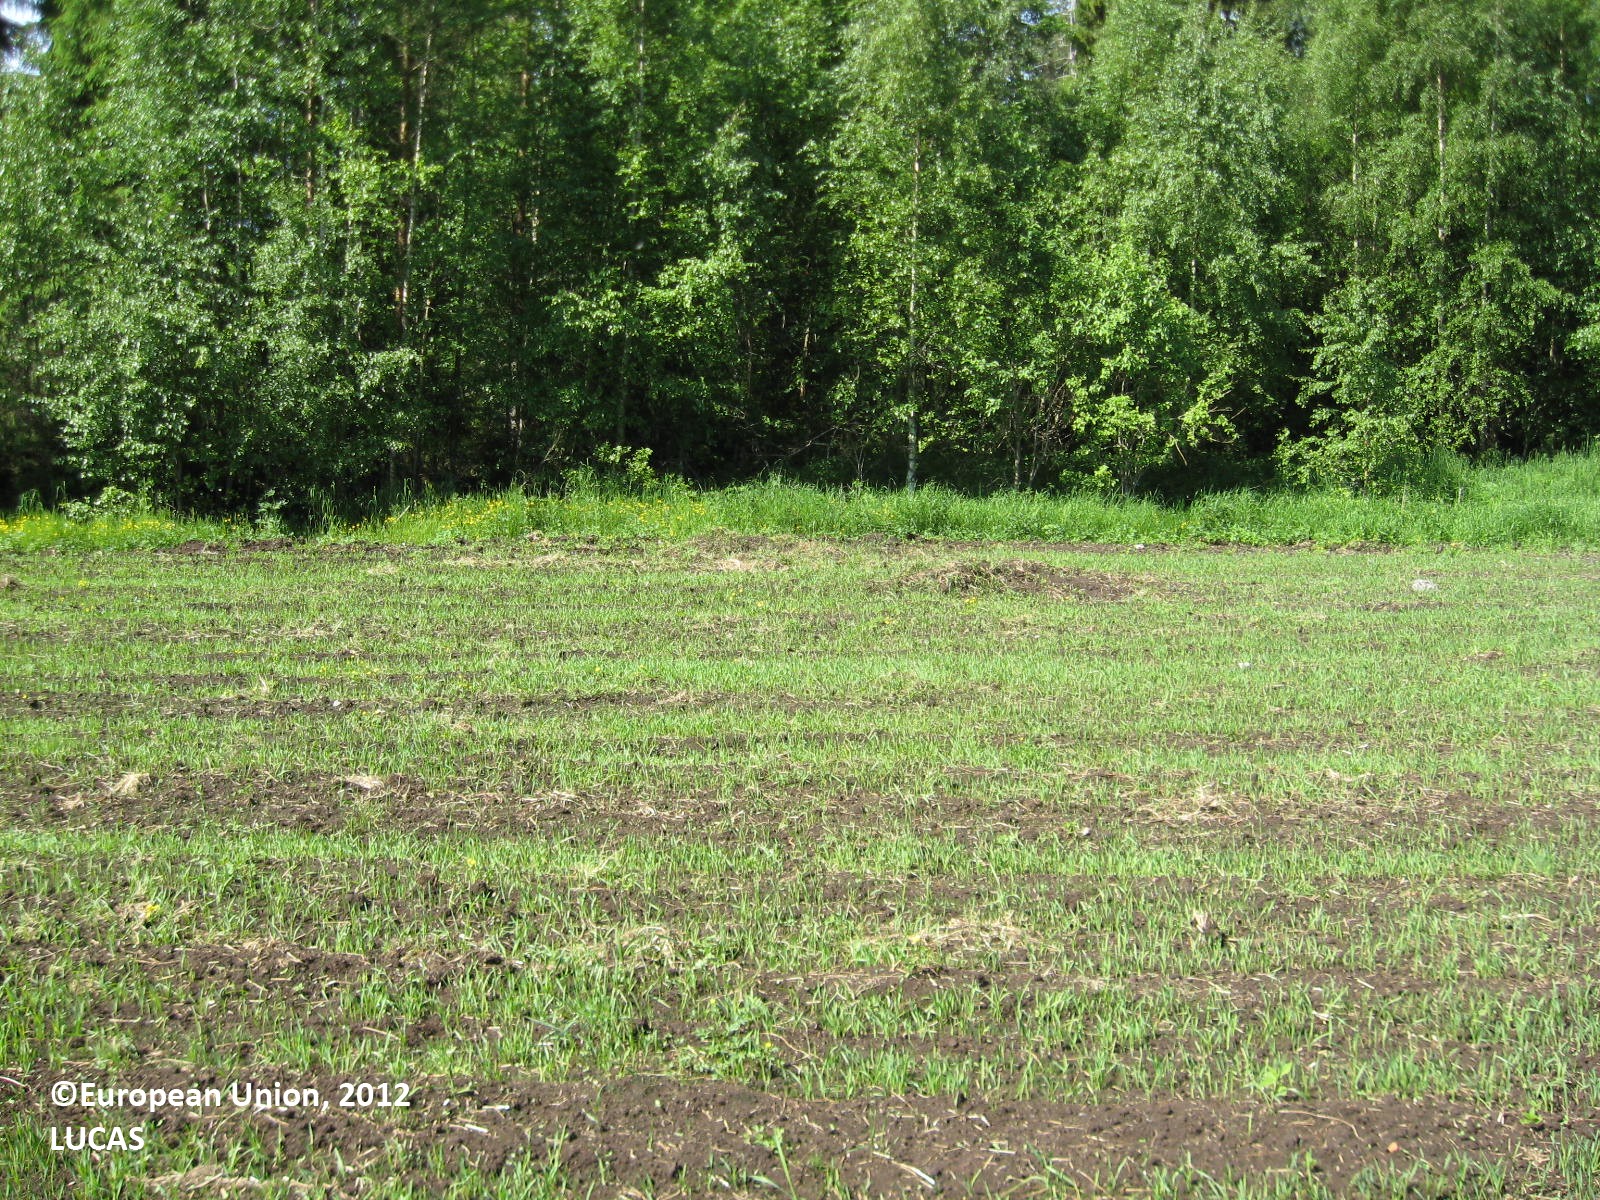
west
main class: Cropland
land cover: Oats
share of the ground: 50 - 75 %
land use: Agriculture (excluding fallow land and kitchen gardens)
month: June
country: FI
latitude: 62.8374
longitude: 21.8451
